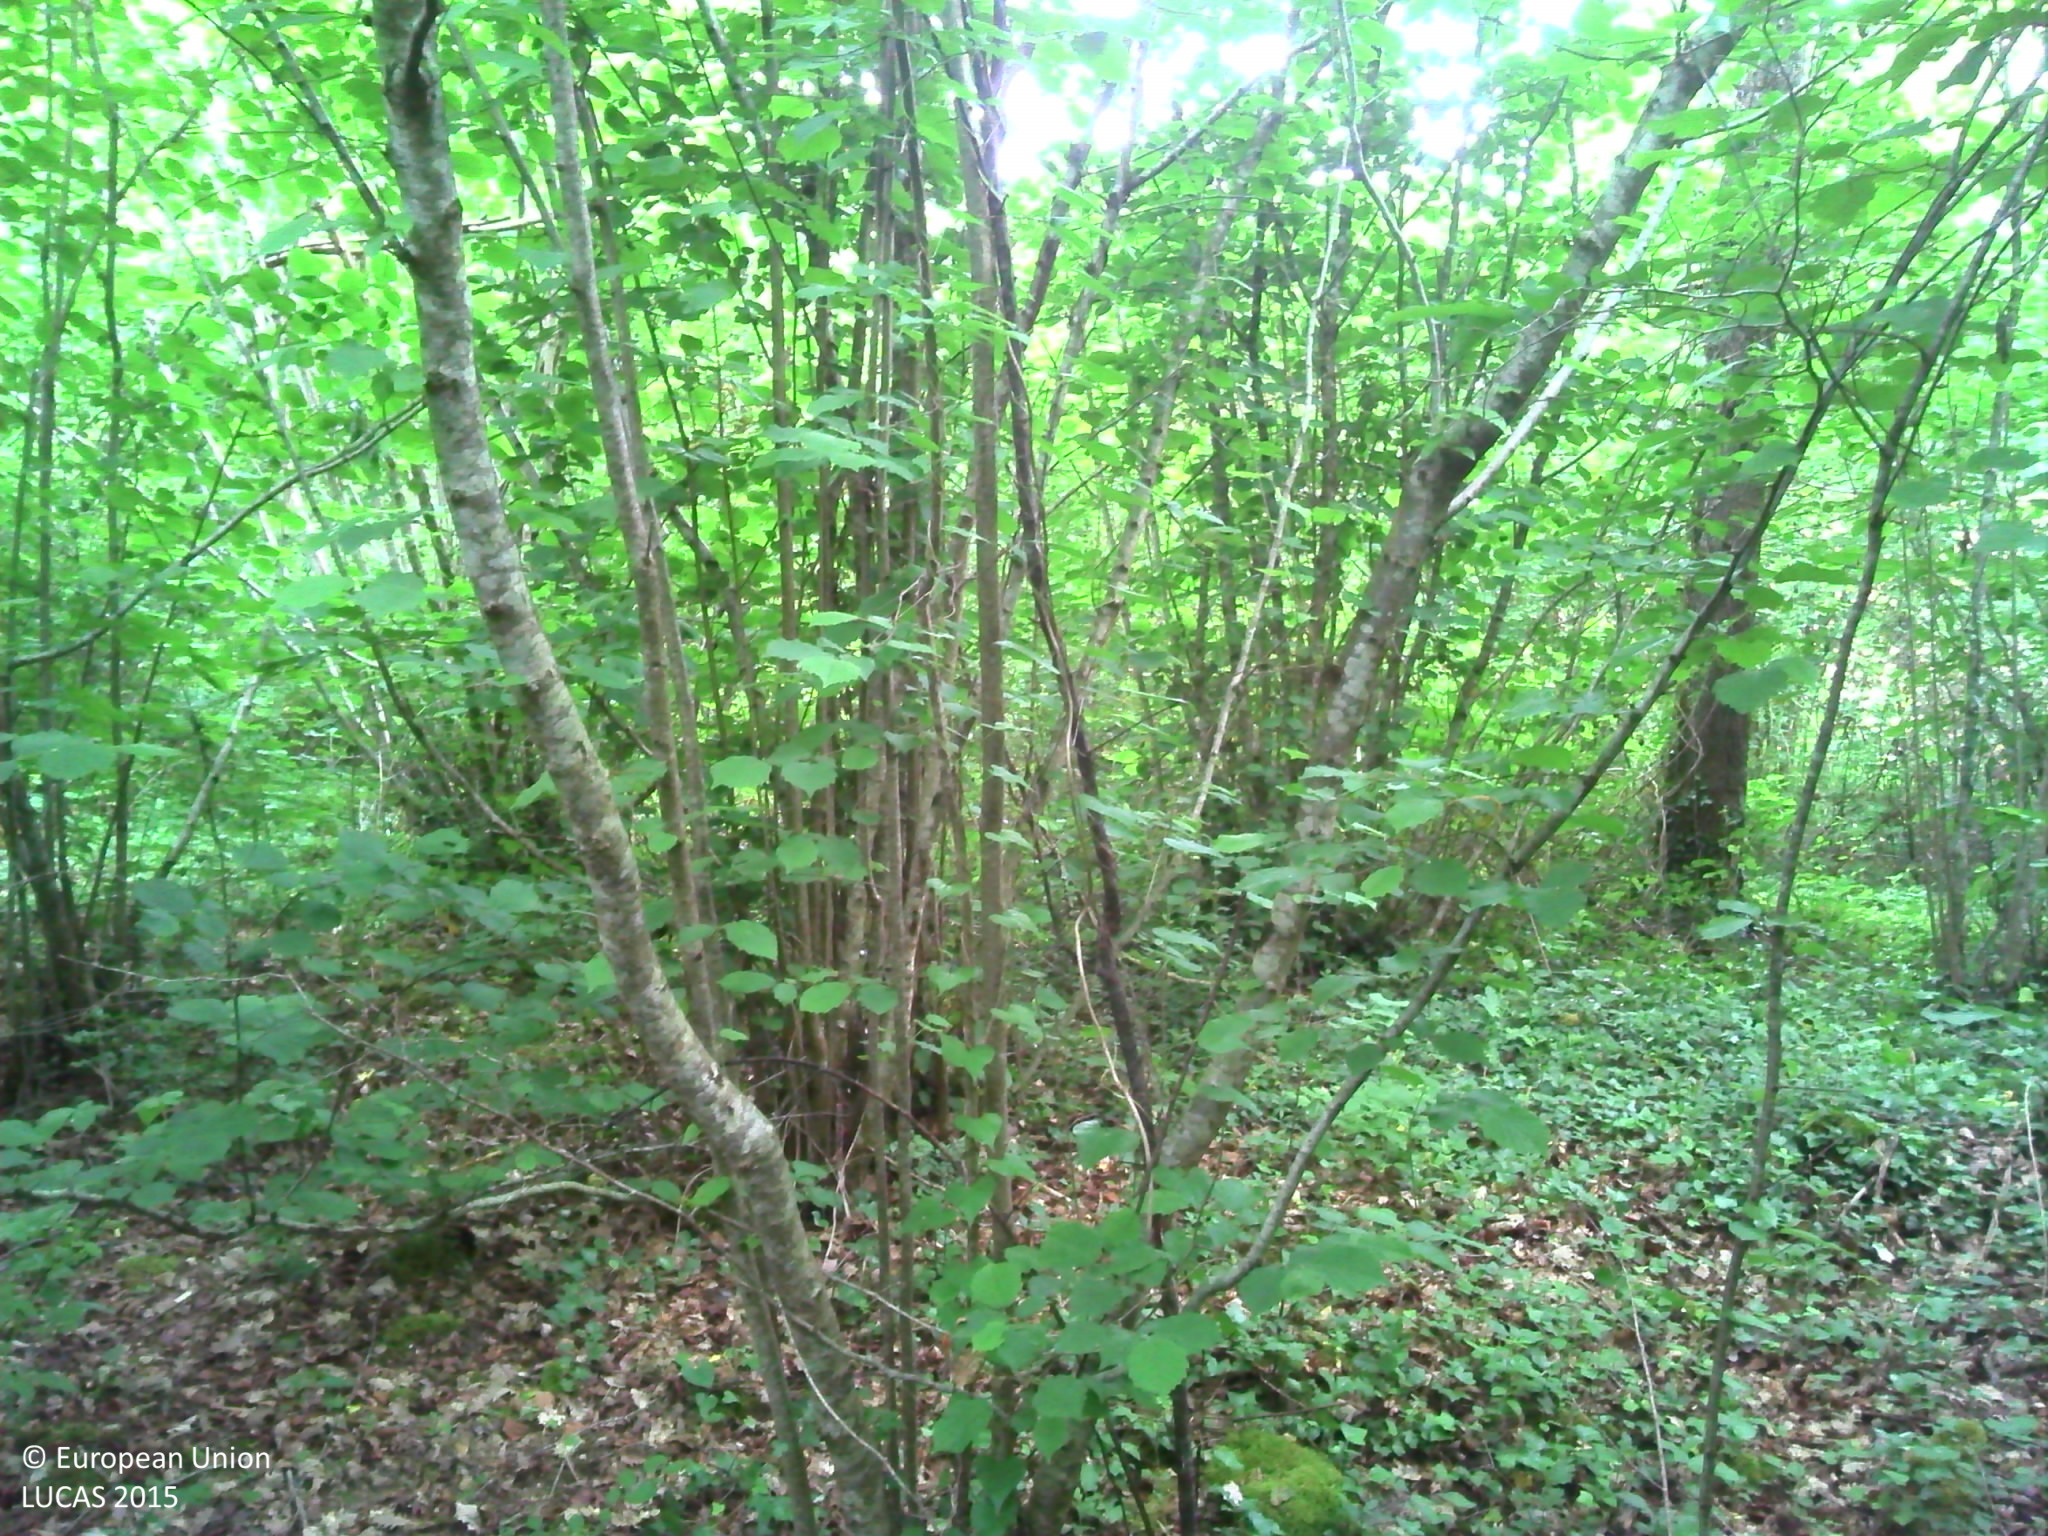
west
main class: Woodland
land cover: Broadleaved woodland
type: thermophilous deciduous forest
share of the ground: > 75 %
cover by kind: broadleaved forest trees 90 %, herbaceous plants 5 %, lichens and mosses 5 %
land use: Forestry
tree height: > 5 m
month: June
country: FR
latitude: 43.6049
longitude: 0.6945
